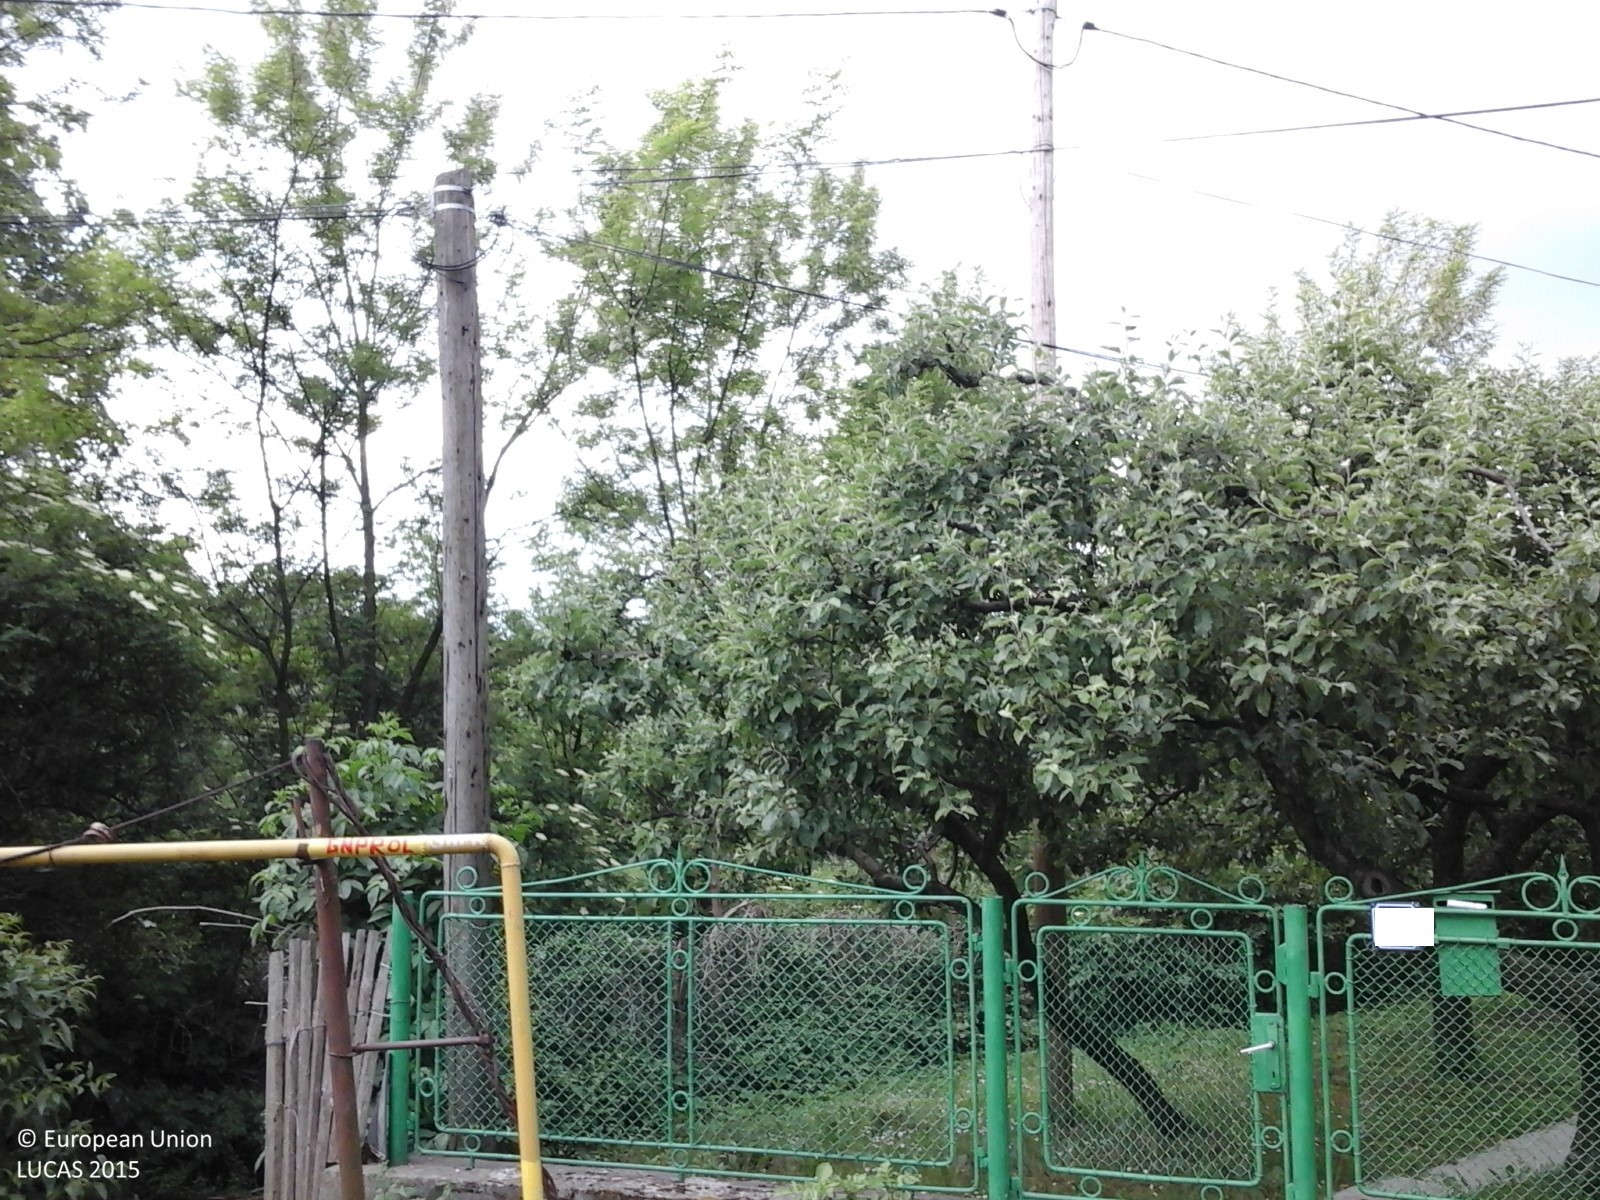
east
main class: Grassland
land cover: Grassland without tree/shrub cover
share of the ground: > 75 %
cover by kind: herbaceous plants 100 %
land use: Residential
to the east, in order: Grassland without tree/shrub cover; Fences; Grassland with sparse tree/shrub cover; Fences; Rivers and streams; Grass margins; Artificial constructions in urban areas; Broadleaved woodland; Arable land (only in case pi)
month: June
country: RO
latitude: 46.4586
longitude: 26.4736
